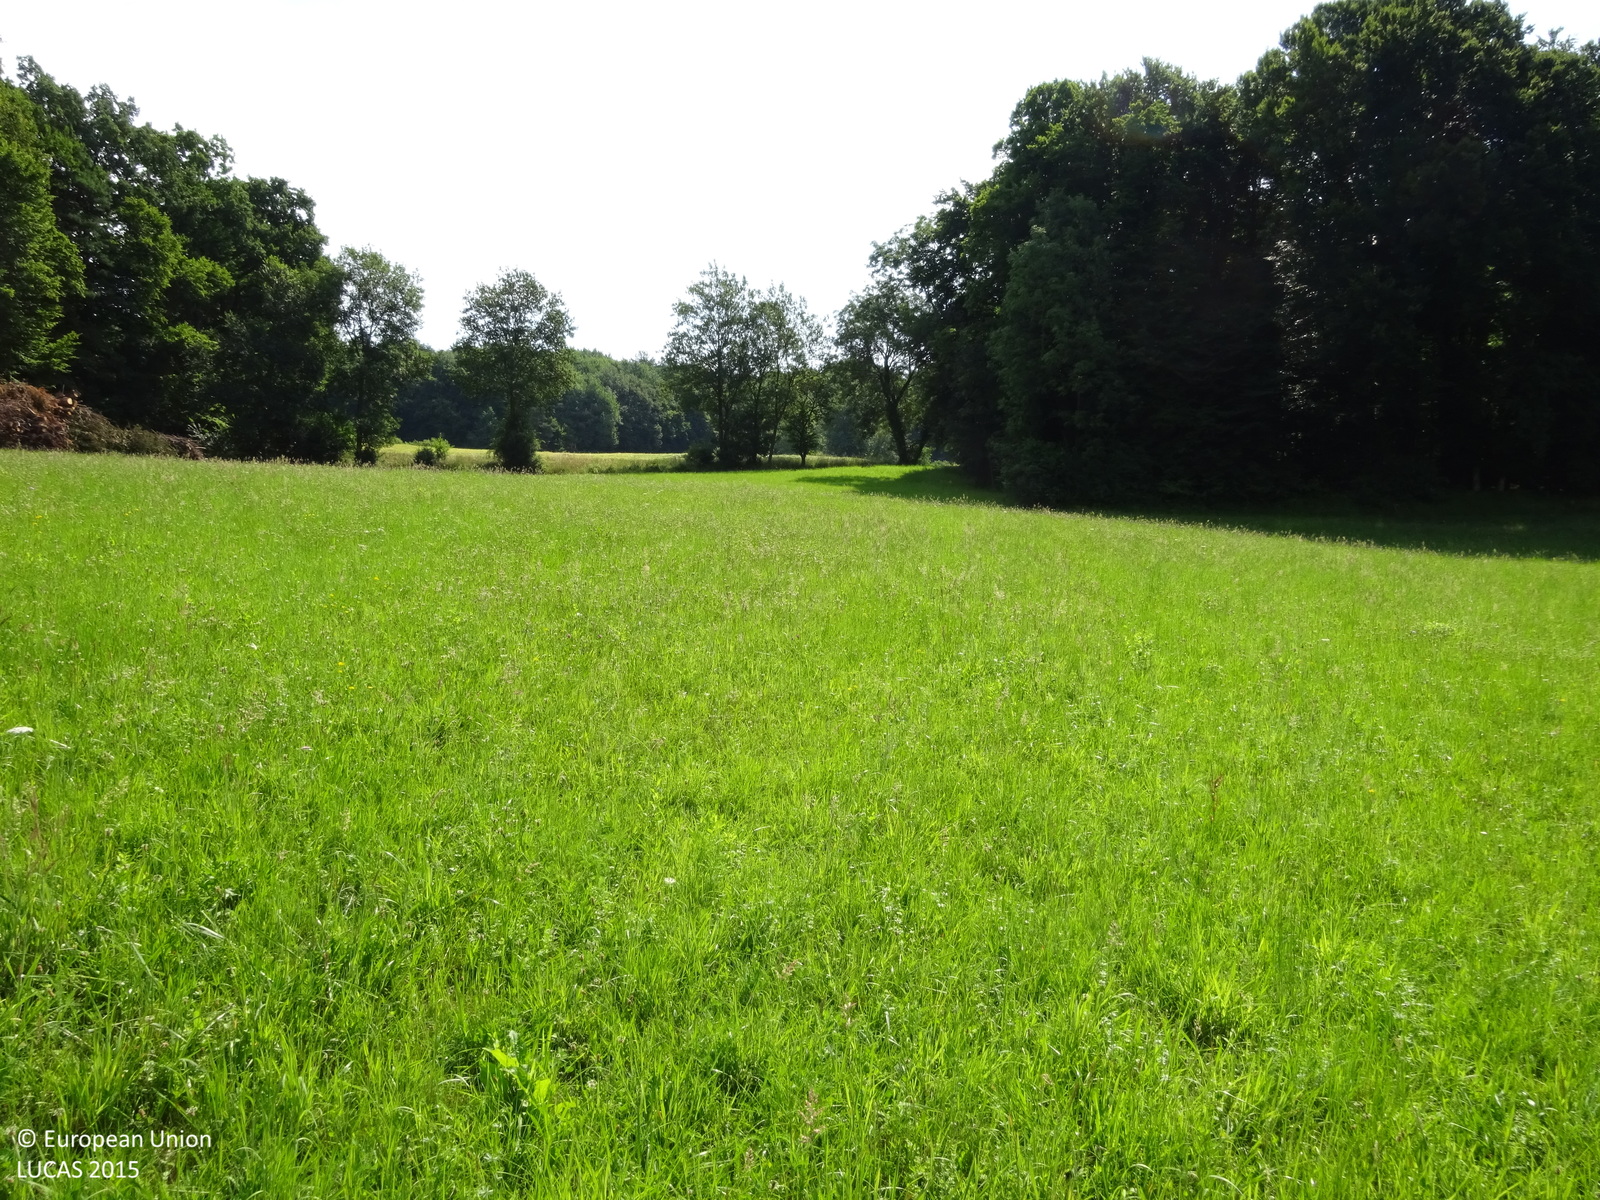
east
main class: Grassland
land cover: Grassland without tree/shrub cover
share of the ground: > 75 %
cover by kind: herbaceous plants 100 %
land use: Agriculture (excluding fallow land and kitchen gardens)
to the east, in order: Grassland without tree/shrub cover; Tracks; Ditches and canals; Single bushes/trees; Grass margins; Barley
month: June
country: AT
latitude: 46.8376
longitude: 15.9137
